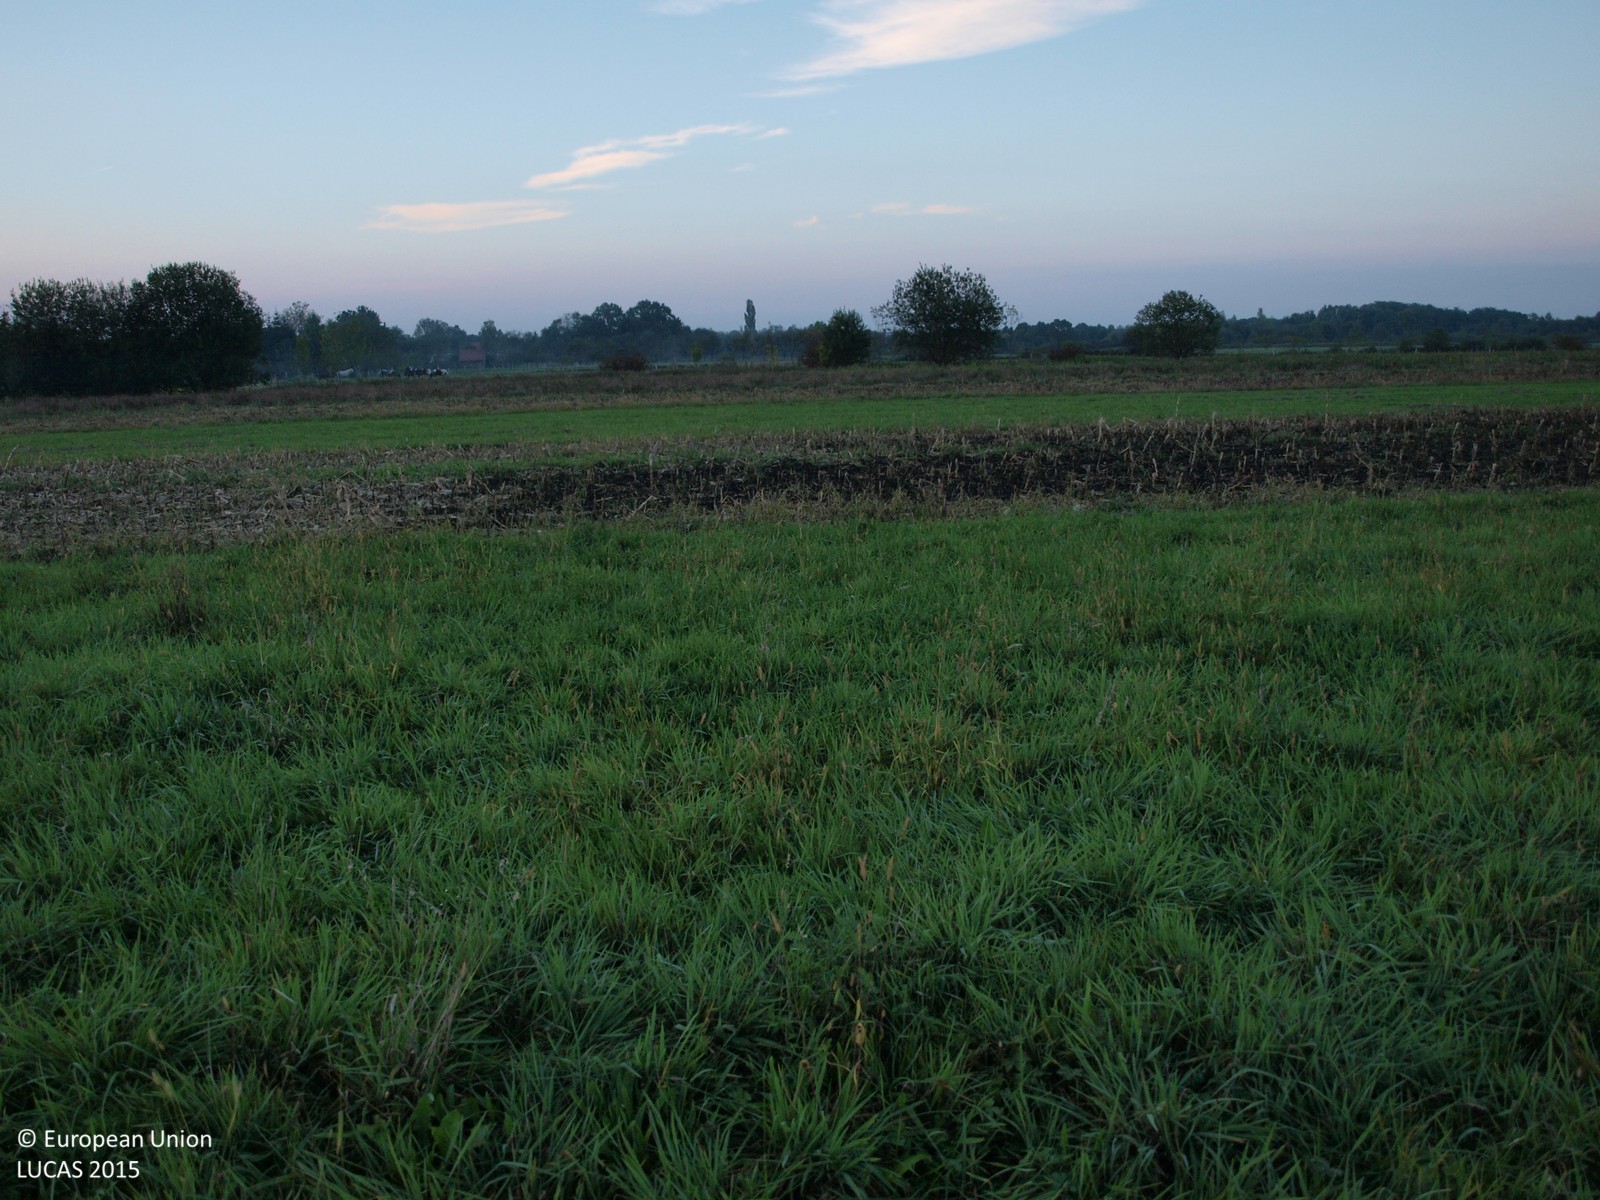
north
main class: Grassland
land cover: Grassland without tree/shrub cover
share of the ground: > 75 %
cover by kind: herbaceous plants 100 %
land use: Agriculture (excluding fallow land and kitchen gardens)
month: October
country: HR
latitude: 45.4846
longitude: 16.2026
